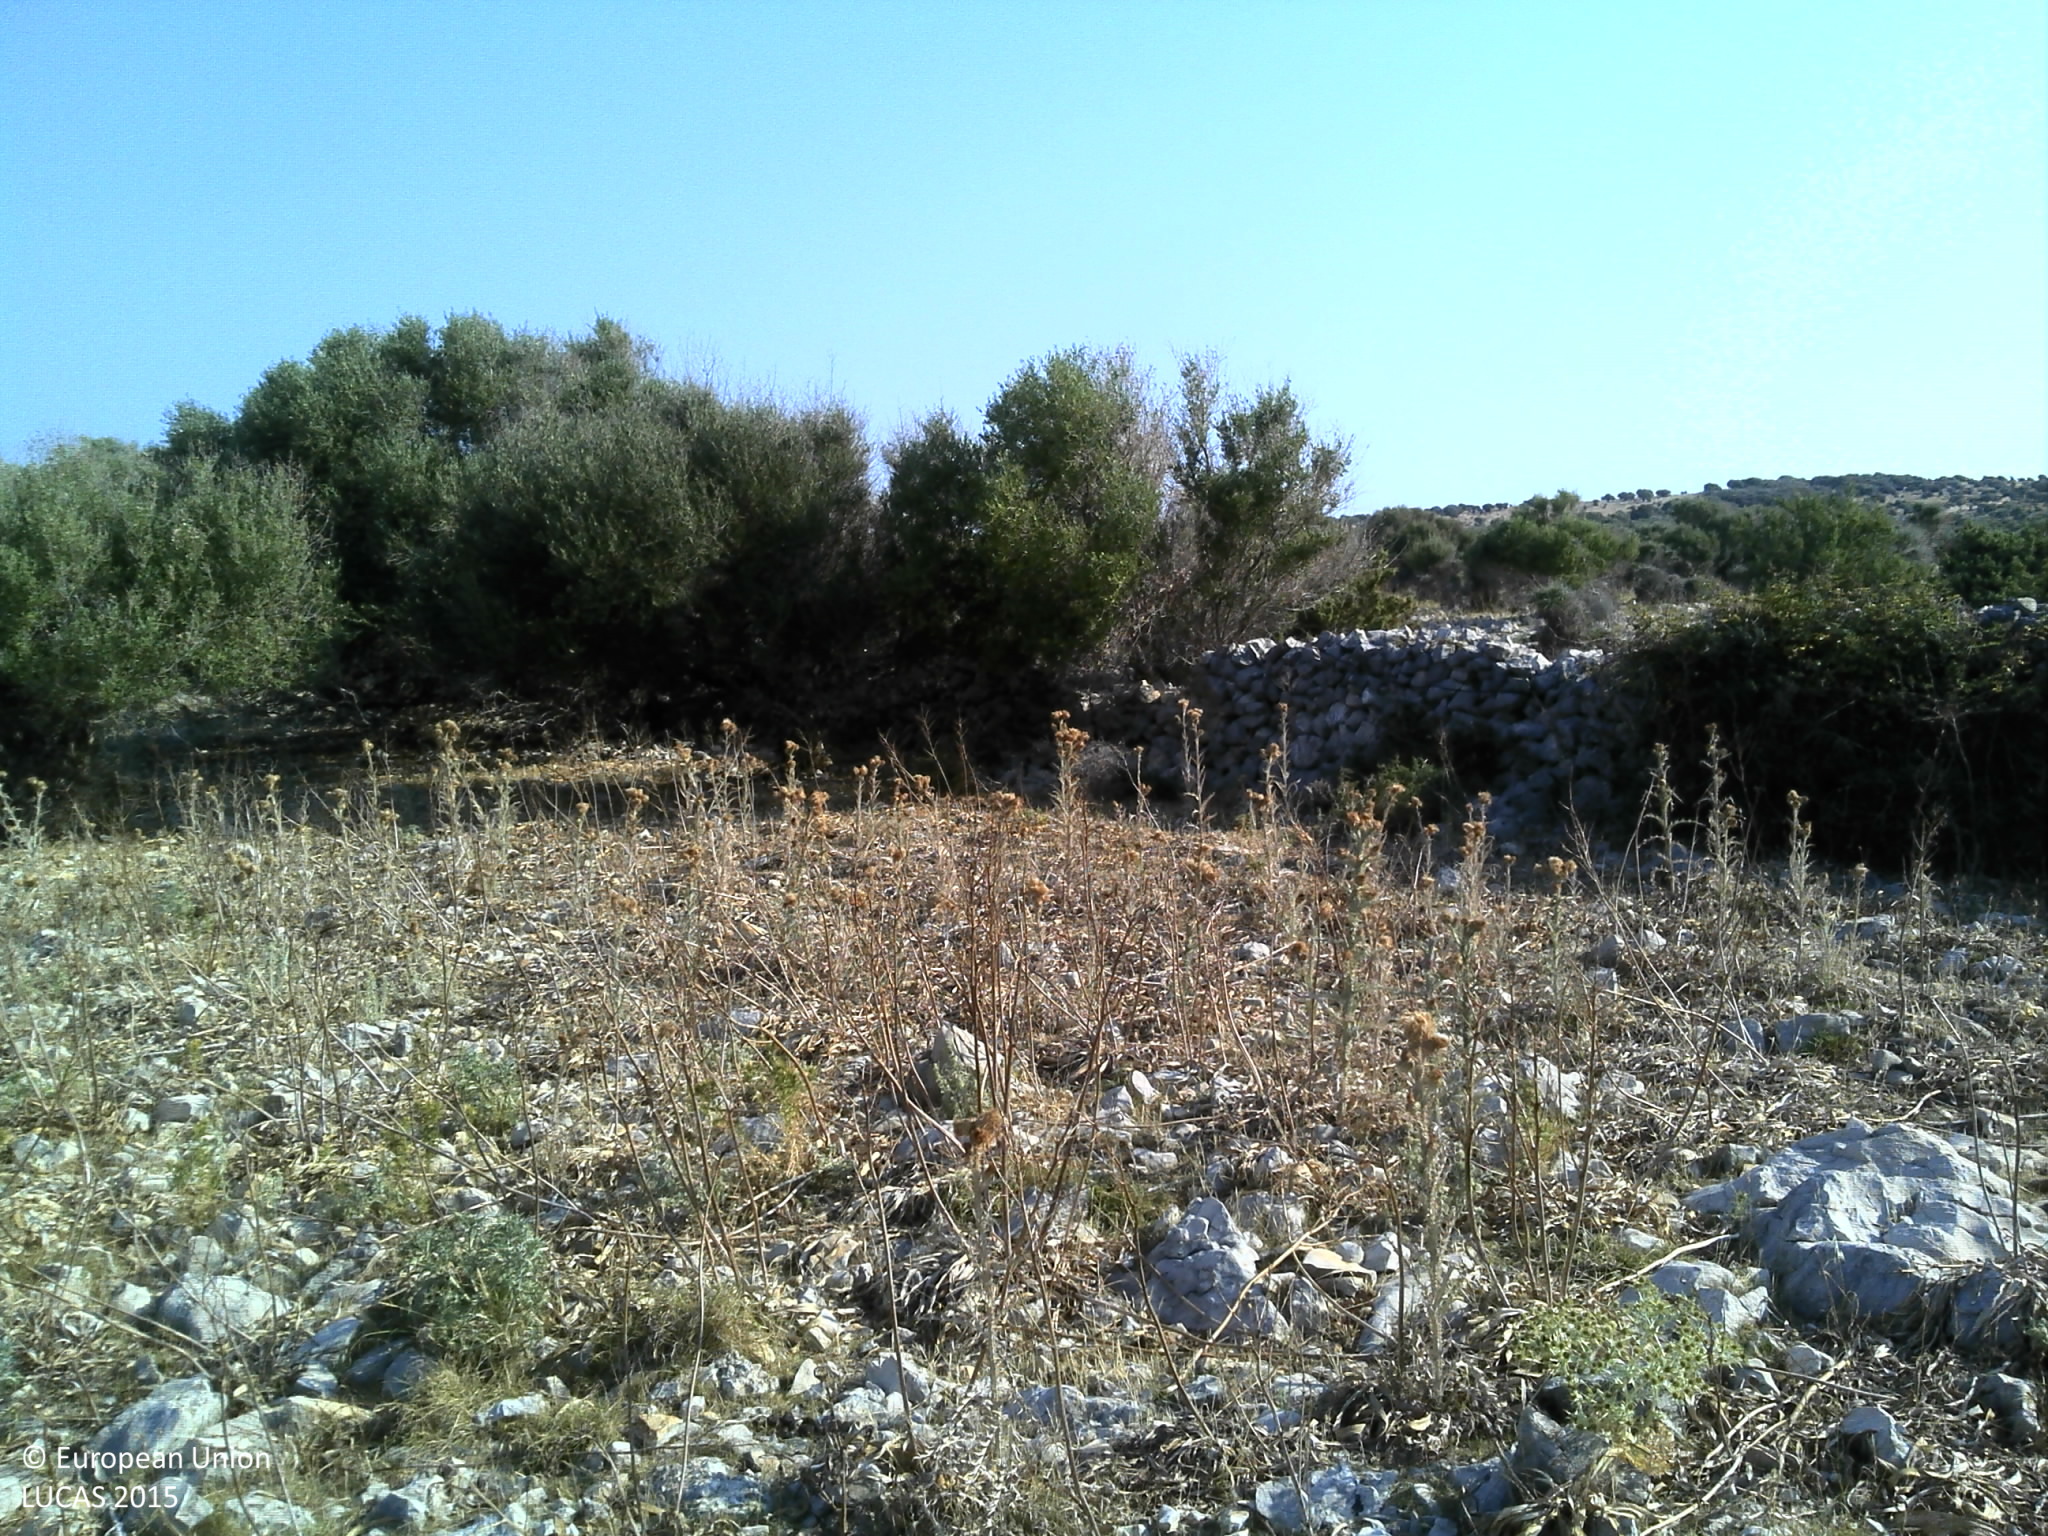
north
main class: Grassland
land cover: Grassland with sparse tree/shrub cover
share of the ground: 25 - 50 %
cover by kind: unconsolidated bare surface 40 %, herbaceous plants 35 %, consolidated bare surface 15 %, broadleaved forest trees 5 %, shrubs 5 %
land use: Agriculture (excluding fallow land and kitchen gardens)
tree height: < 5 m
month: July
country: HR
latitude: 44.6371
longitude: 14.7964
